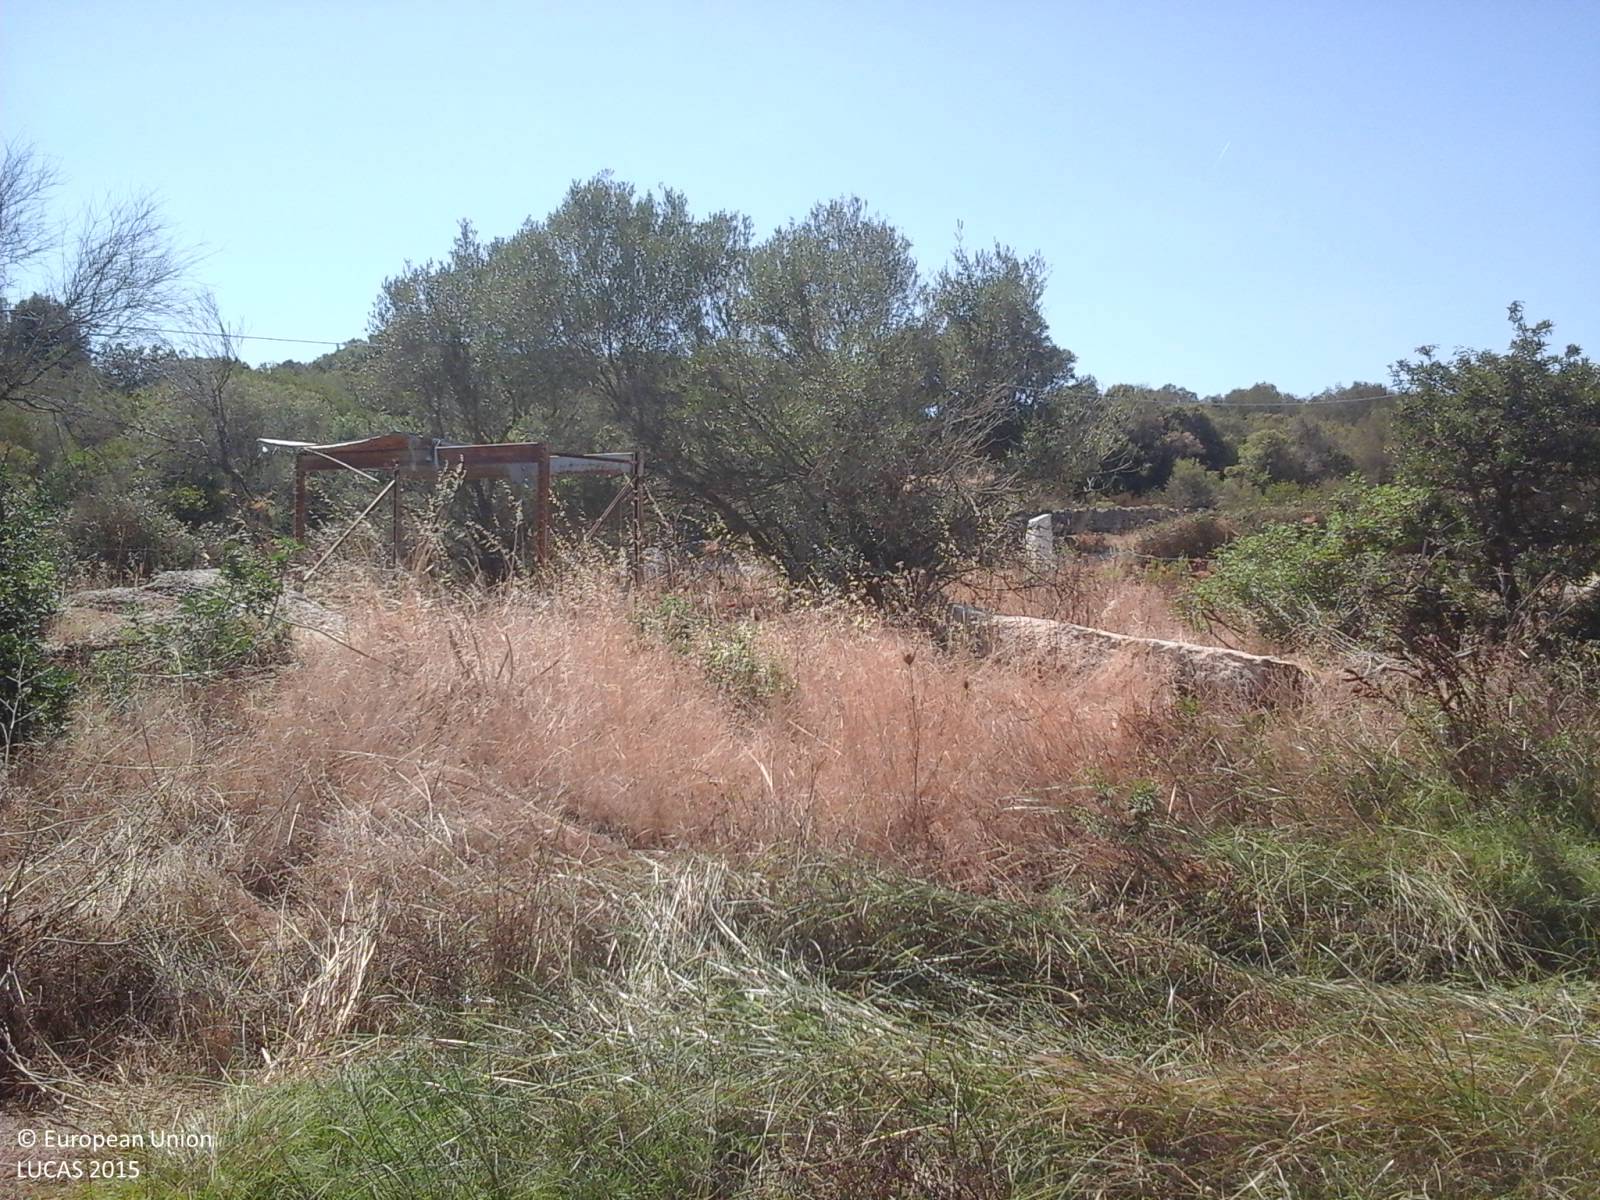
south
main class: Grassland
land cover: Grassland without tree/shrub cover
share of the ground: > 75 %
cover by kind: herbaceous plants 95 %, unconsolidated bare surface 5 %
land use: Agriculture (excluding fallow land and kitchen gardens)
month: August
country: IT
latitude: 41.0256
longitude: 9.4199
